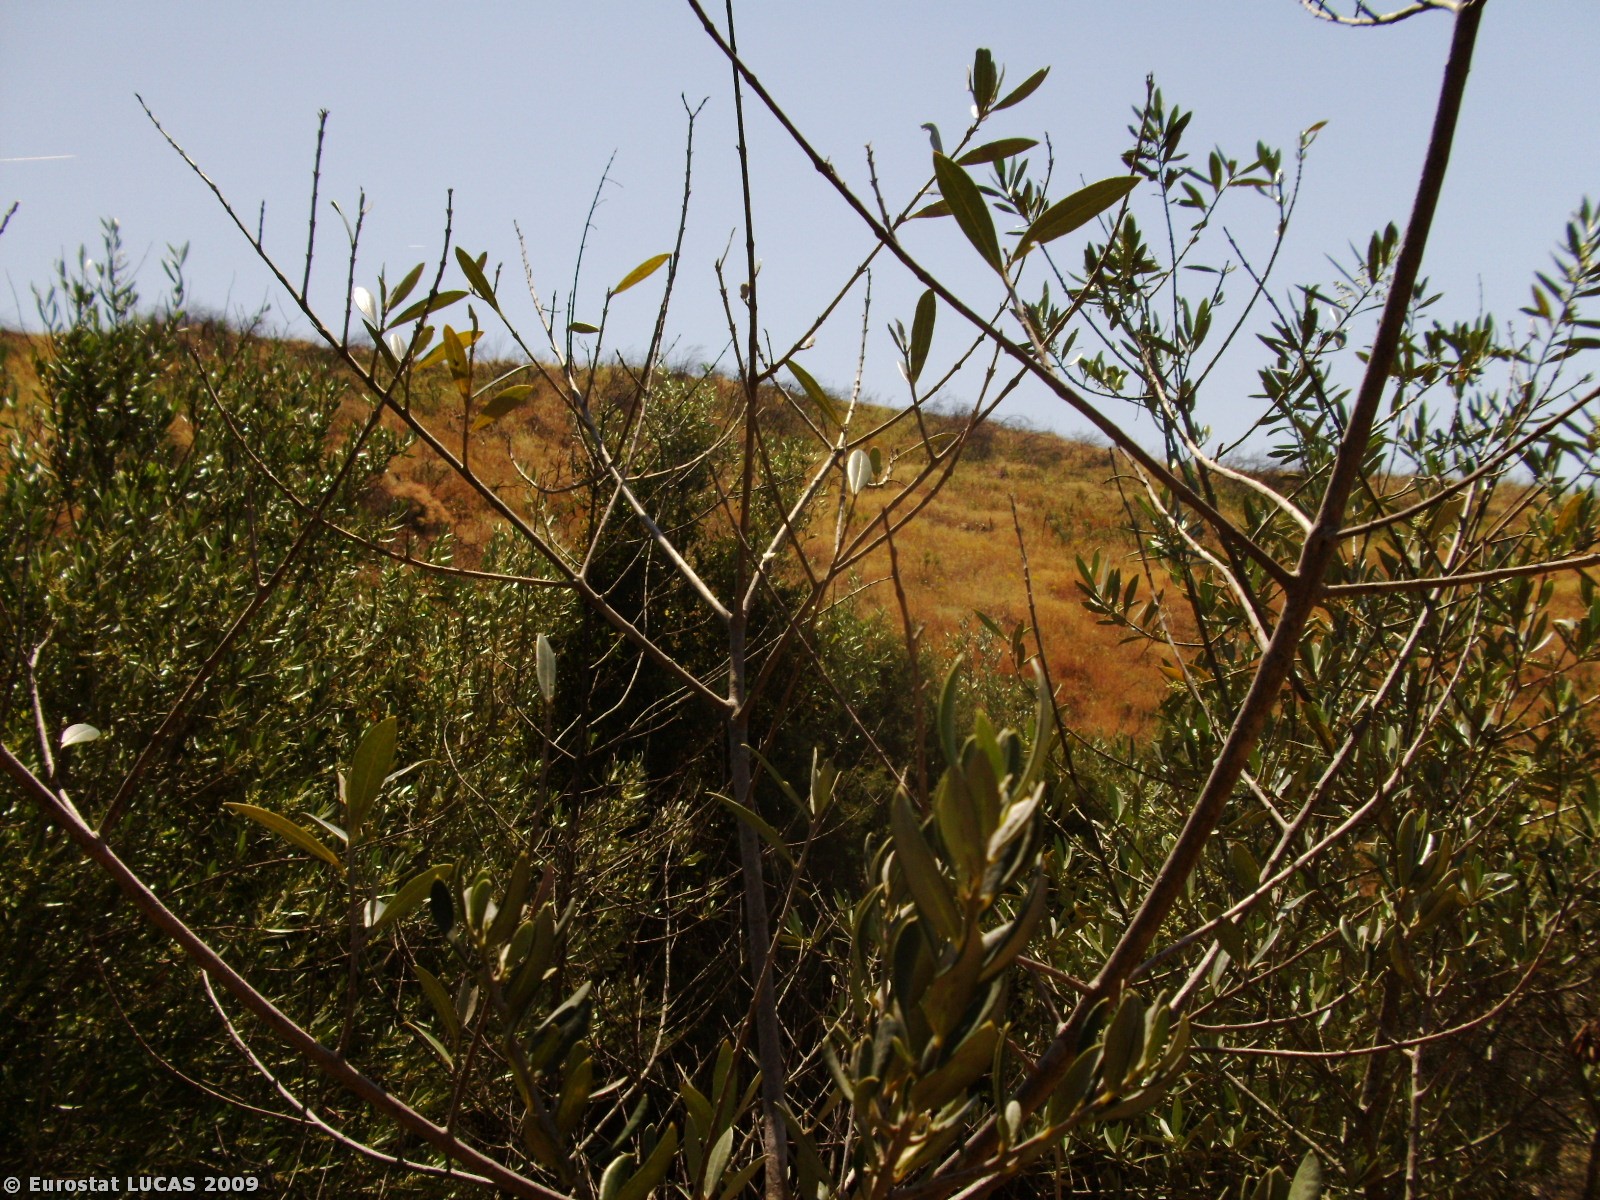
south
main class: Cropland
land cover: Olive groves
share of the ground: 25 - 50 %
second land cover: Spontaneously vegetated surfaces
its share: > 75 %
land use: Fallow land
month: May
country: PT
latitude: 37.5155
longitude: -7.6049
